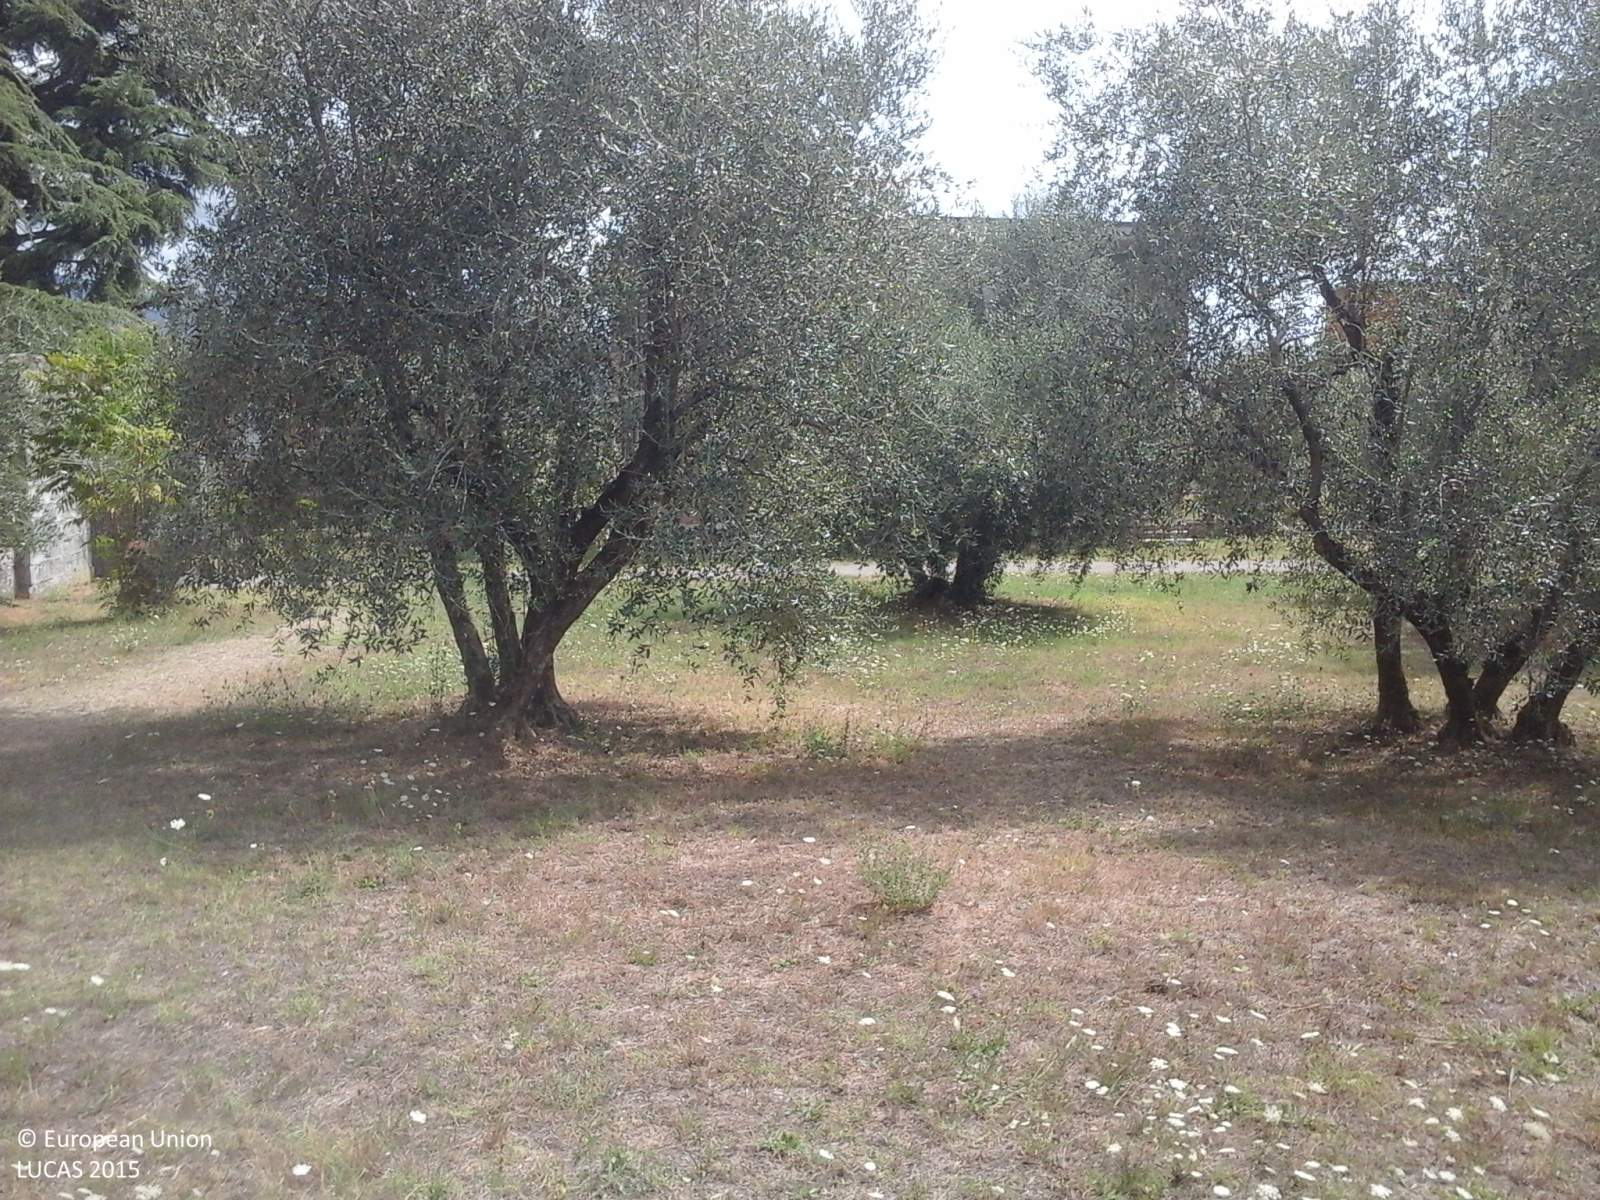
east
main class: Cropland
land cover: Olive groves
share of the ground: > 75 %
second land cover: Grassland without tree/shrub cover
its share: > 75 %
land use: Community services
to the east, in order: Olive groves; Grassland without tree/shrub cover; Artificial constructions in urban areas; Grassland with sparse tree/shrub cover; Paved roads, cycling and walking lanes; Fences; Olive groves; Grassland without tree/shrub cover; Fences; Other fresh vegetables
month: August
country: IT
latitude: 43.9497
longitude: 10.9073
